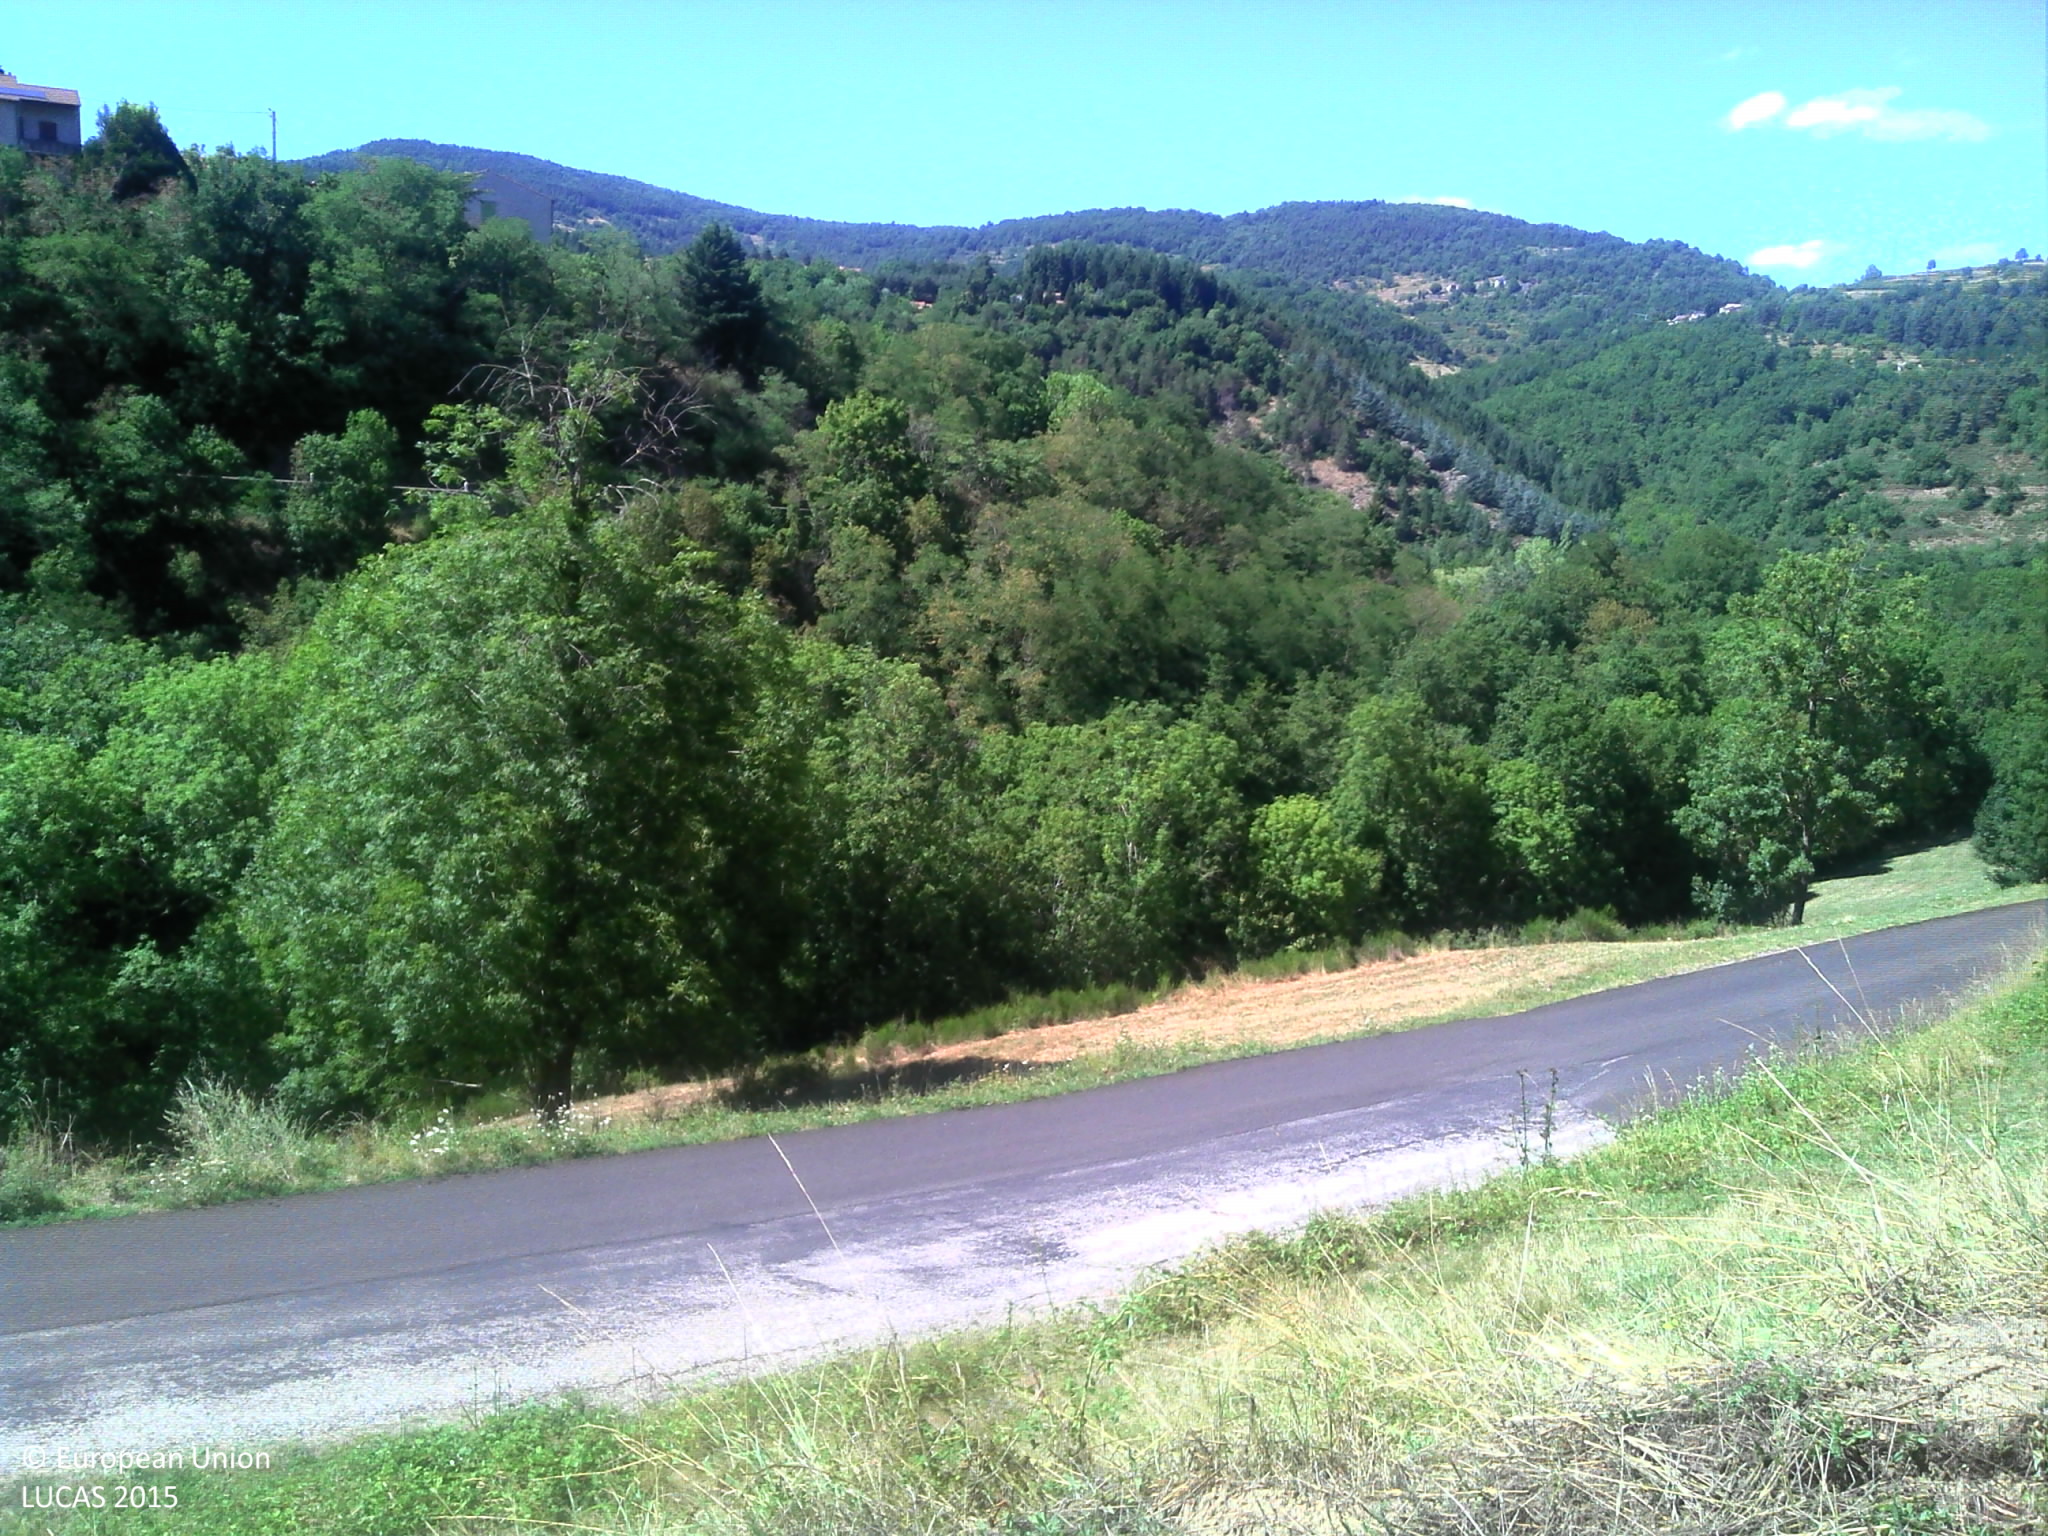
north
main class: Woodland
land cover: Broadleaved woodland
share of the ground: > 75 %
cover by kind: broadleaved forest trees 70 %, herbaceous plants 30 %
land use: Semi-natural and natural areas not in use
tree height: > 5 m
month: July
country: FR
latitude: 44.9864
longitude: 4.5897
